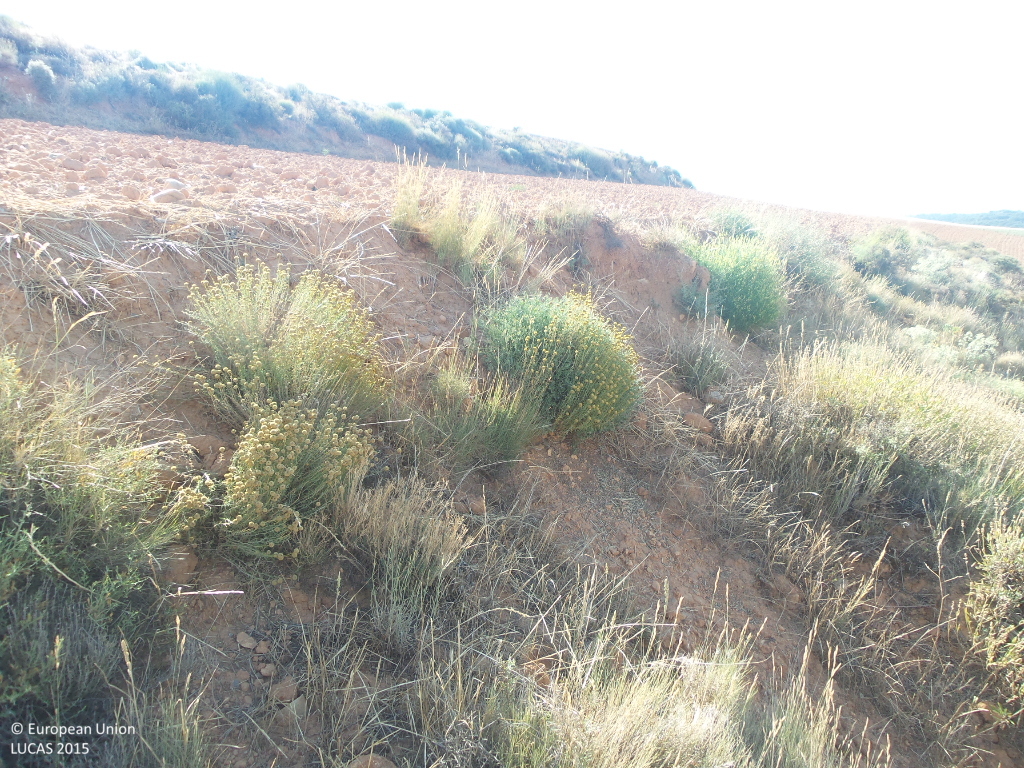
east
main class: Shrubland
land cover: Shrubland without tree cover
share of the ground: 50 - 75 %
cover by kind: shrubs 50 %, unconsolidated bare surface 40 %, herbaceous plants 10 %
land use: Semi-natural and natural areas not in use
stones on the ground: < 10 %
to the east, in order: Shrubland without tree cover; Other bare soil; Shrubland without tree cover; Other bare soil; Shrubland without tree cover; Grass margins; Other bare soil
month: July
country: ES
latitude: 41.2036
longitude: -2.0362
